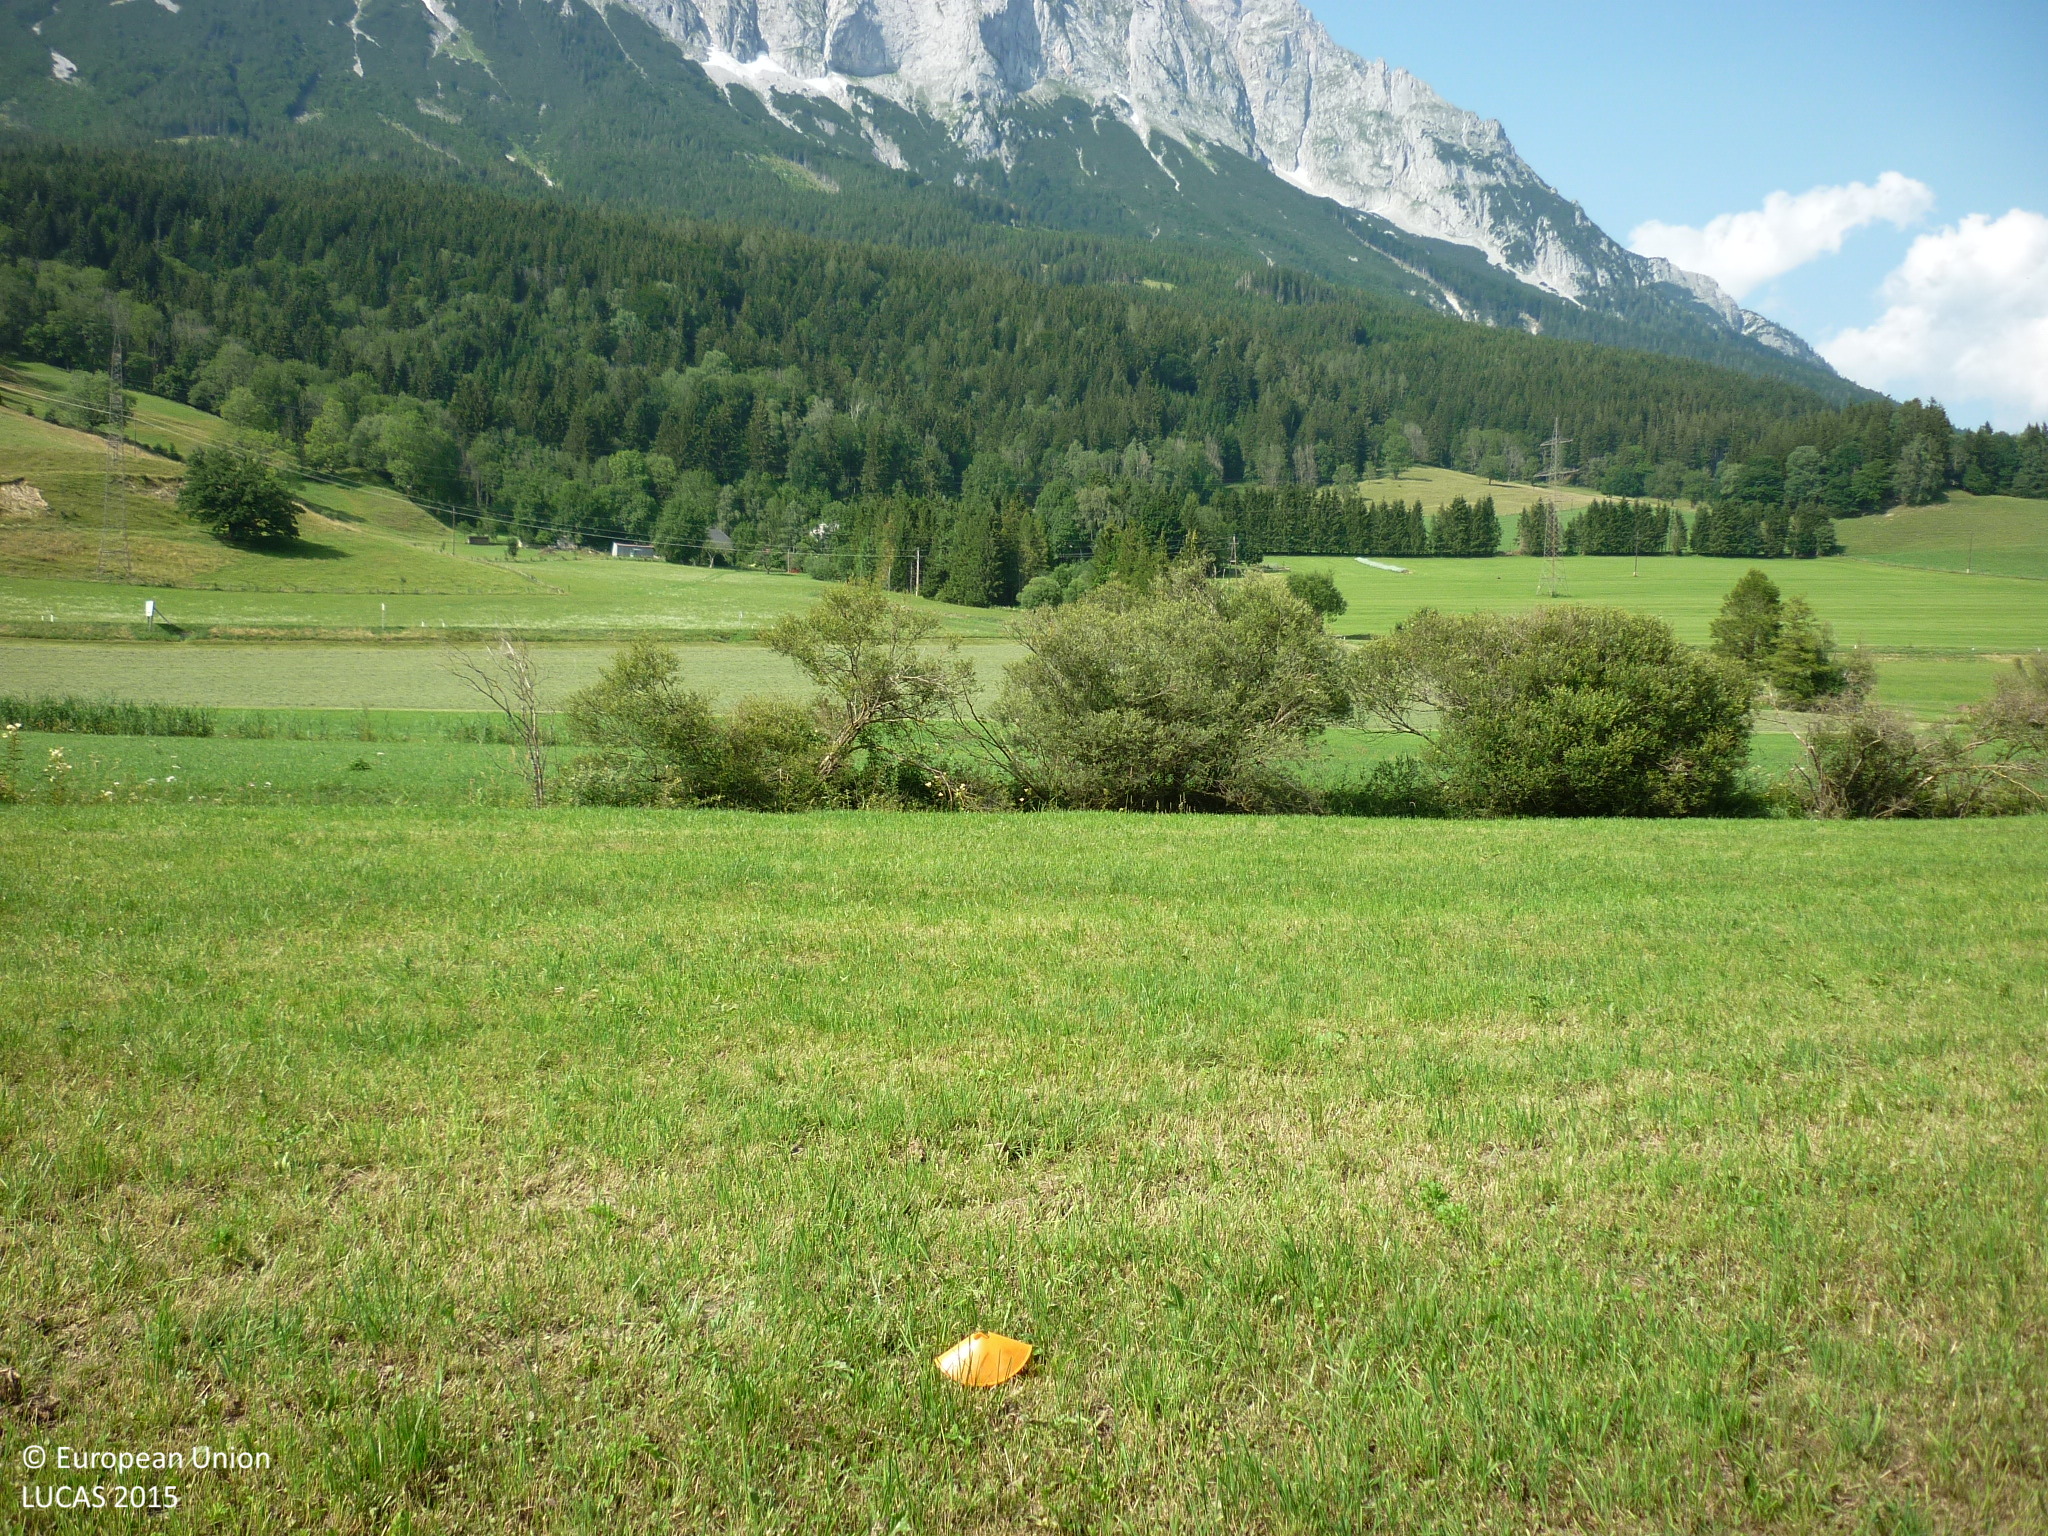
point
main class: Grassland
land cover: Grassland without tree/shrub cover
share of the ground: > 75 %
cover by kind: herbaceous plants 100 %
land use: Agriculture (excluding fallow land and kitchen gardens)
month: July
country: AT
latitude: 47.4845
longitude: 13.9933
